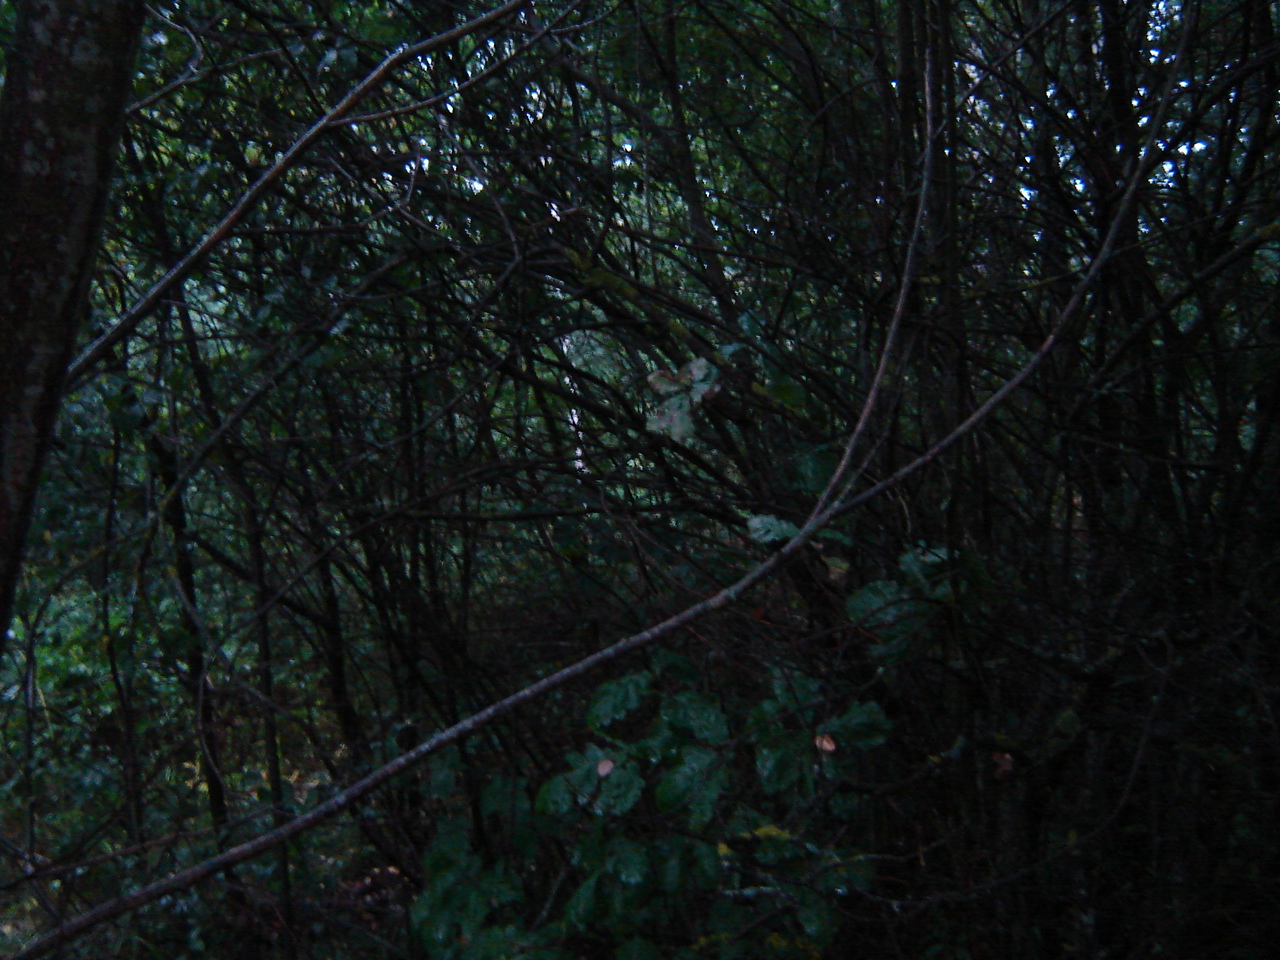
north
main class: Woodland
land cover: Broadleaved woodland
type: mire and swamp forests
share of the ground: > 75 %
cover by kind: broadleaved forest trees 95 %, coniferous forest trees 5 %
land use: Forestry
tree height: > 5 m
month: September
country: LT
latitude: 54.9839
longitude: 25.3264
